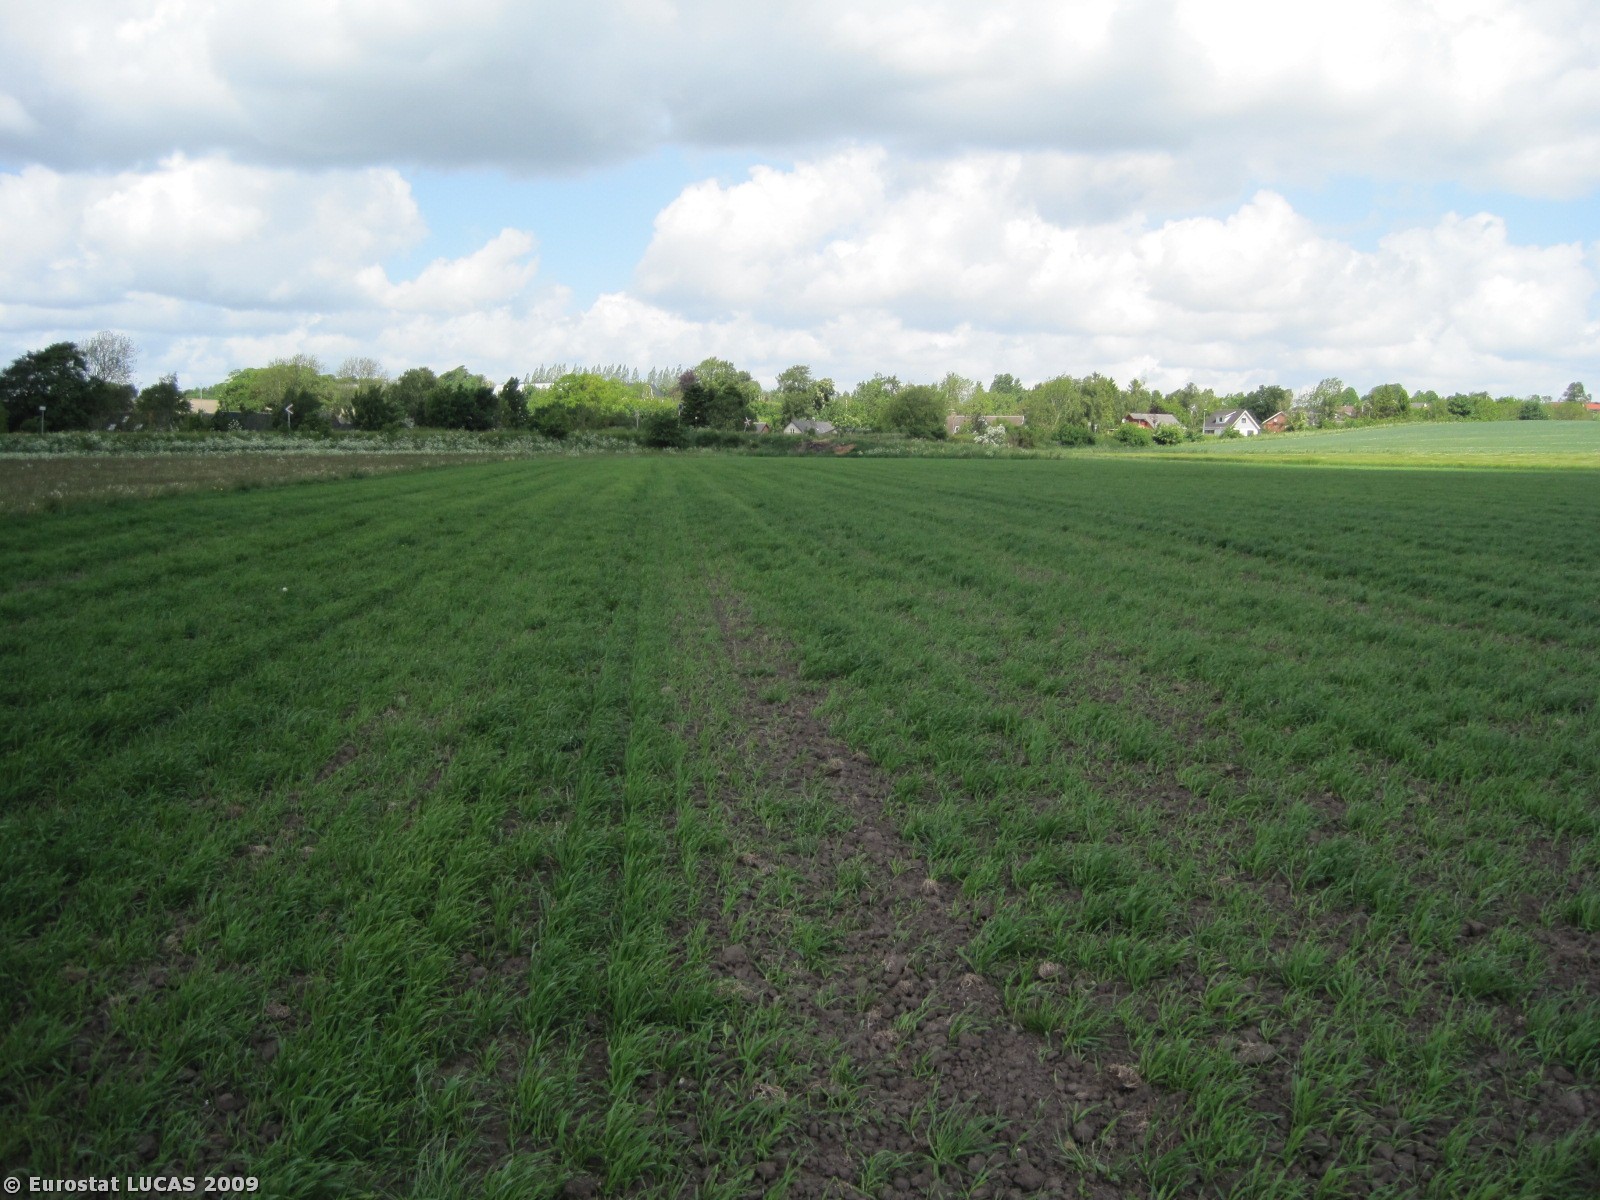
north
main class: Cropland
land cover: Barley
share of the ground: 50 - 75 %
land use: Agriculture (excluding fallow land and kitchen gardens)
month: May
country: DK
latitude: 56.5651
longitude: 9.8212
